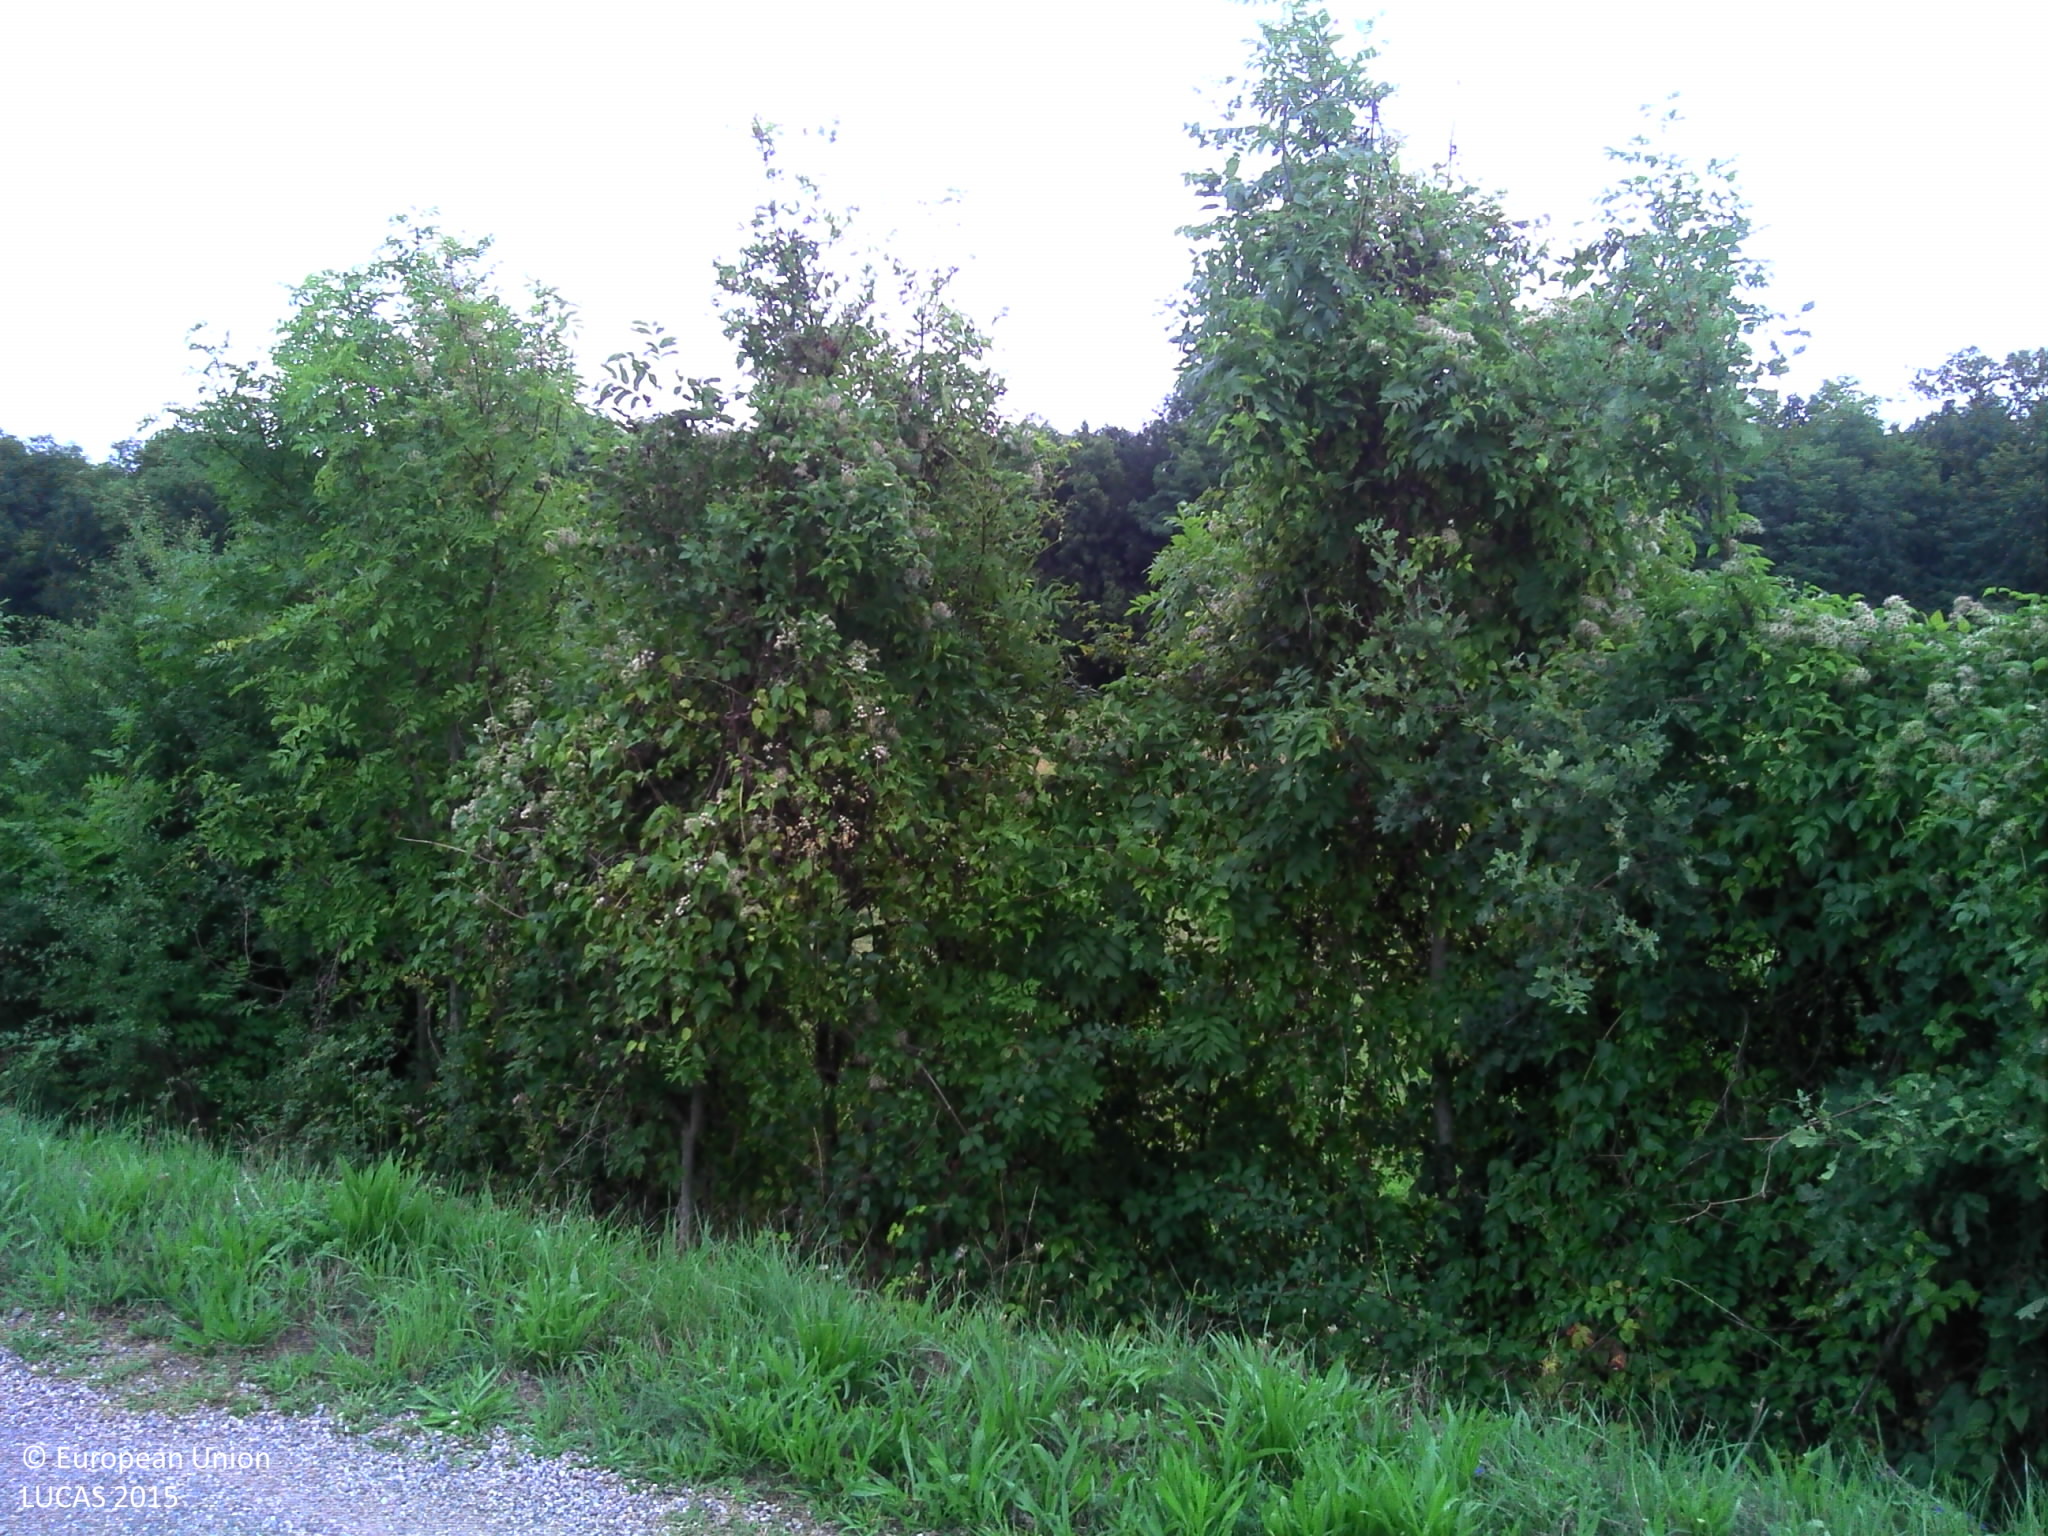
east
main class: Woodland
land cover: Broadleaved woodland
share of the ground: > 75 %
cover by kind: broadleaved forest trees 60 %, herbaceous plants 35 %, coniferous forest trees 5 %
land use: Semi-natural and natural areas not in use
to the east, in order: Broadleaved woodland; Fences; Paved roads, cycling and walking lanes; Fences; Grass margins; Ditches and canals; Shrubland without tree cover; Fences; Grass margins; Paved roads, cycling and walking lanes; Grass margins; Ditches and canals; Lines of trees; Grassland without tree/shrub cover; Soya; Broadleaved woodland; Inland fresh running water; Broadleaved woodland; Tracks; Broadleaved woodland; Fences; Common wheat
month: August
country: FR
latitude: 48.0665
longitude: 7.3843
